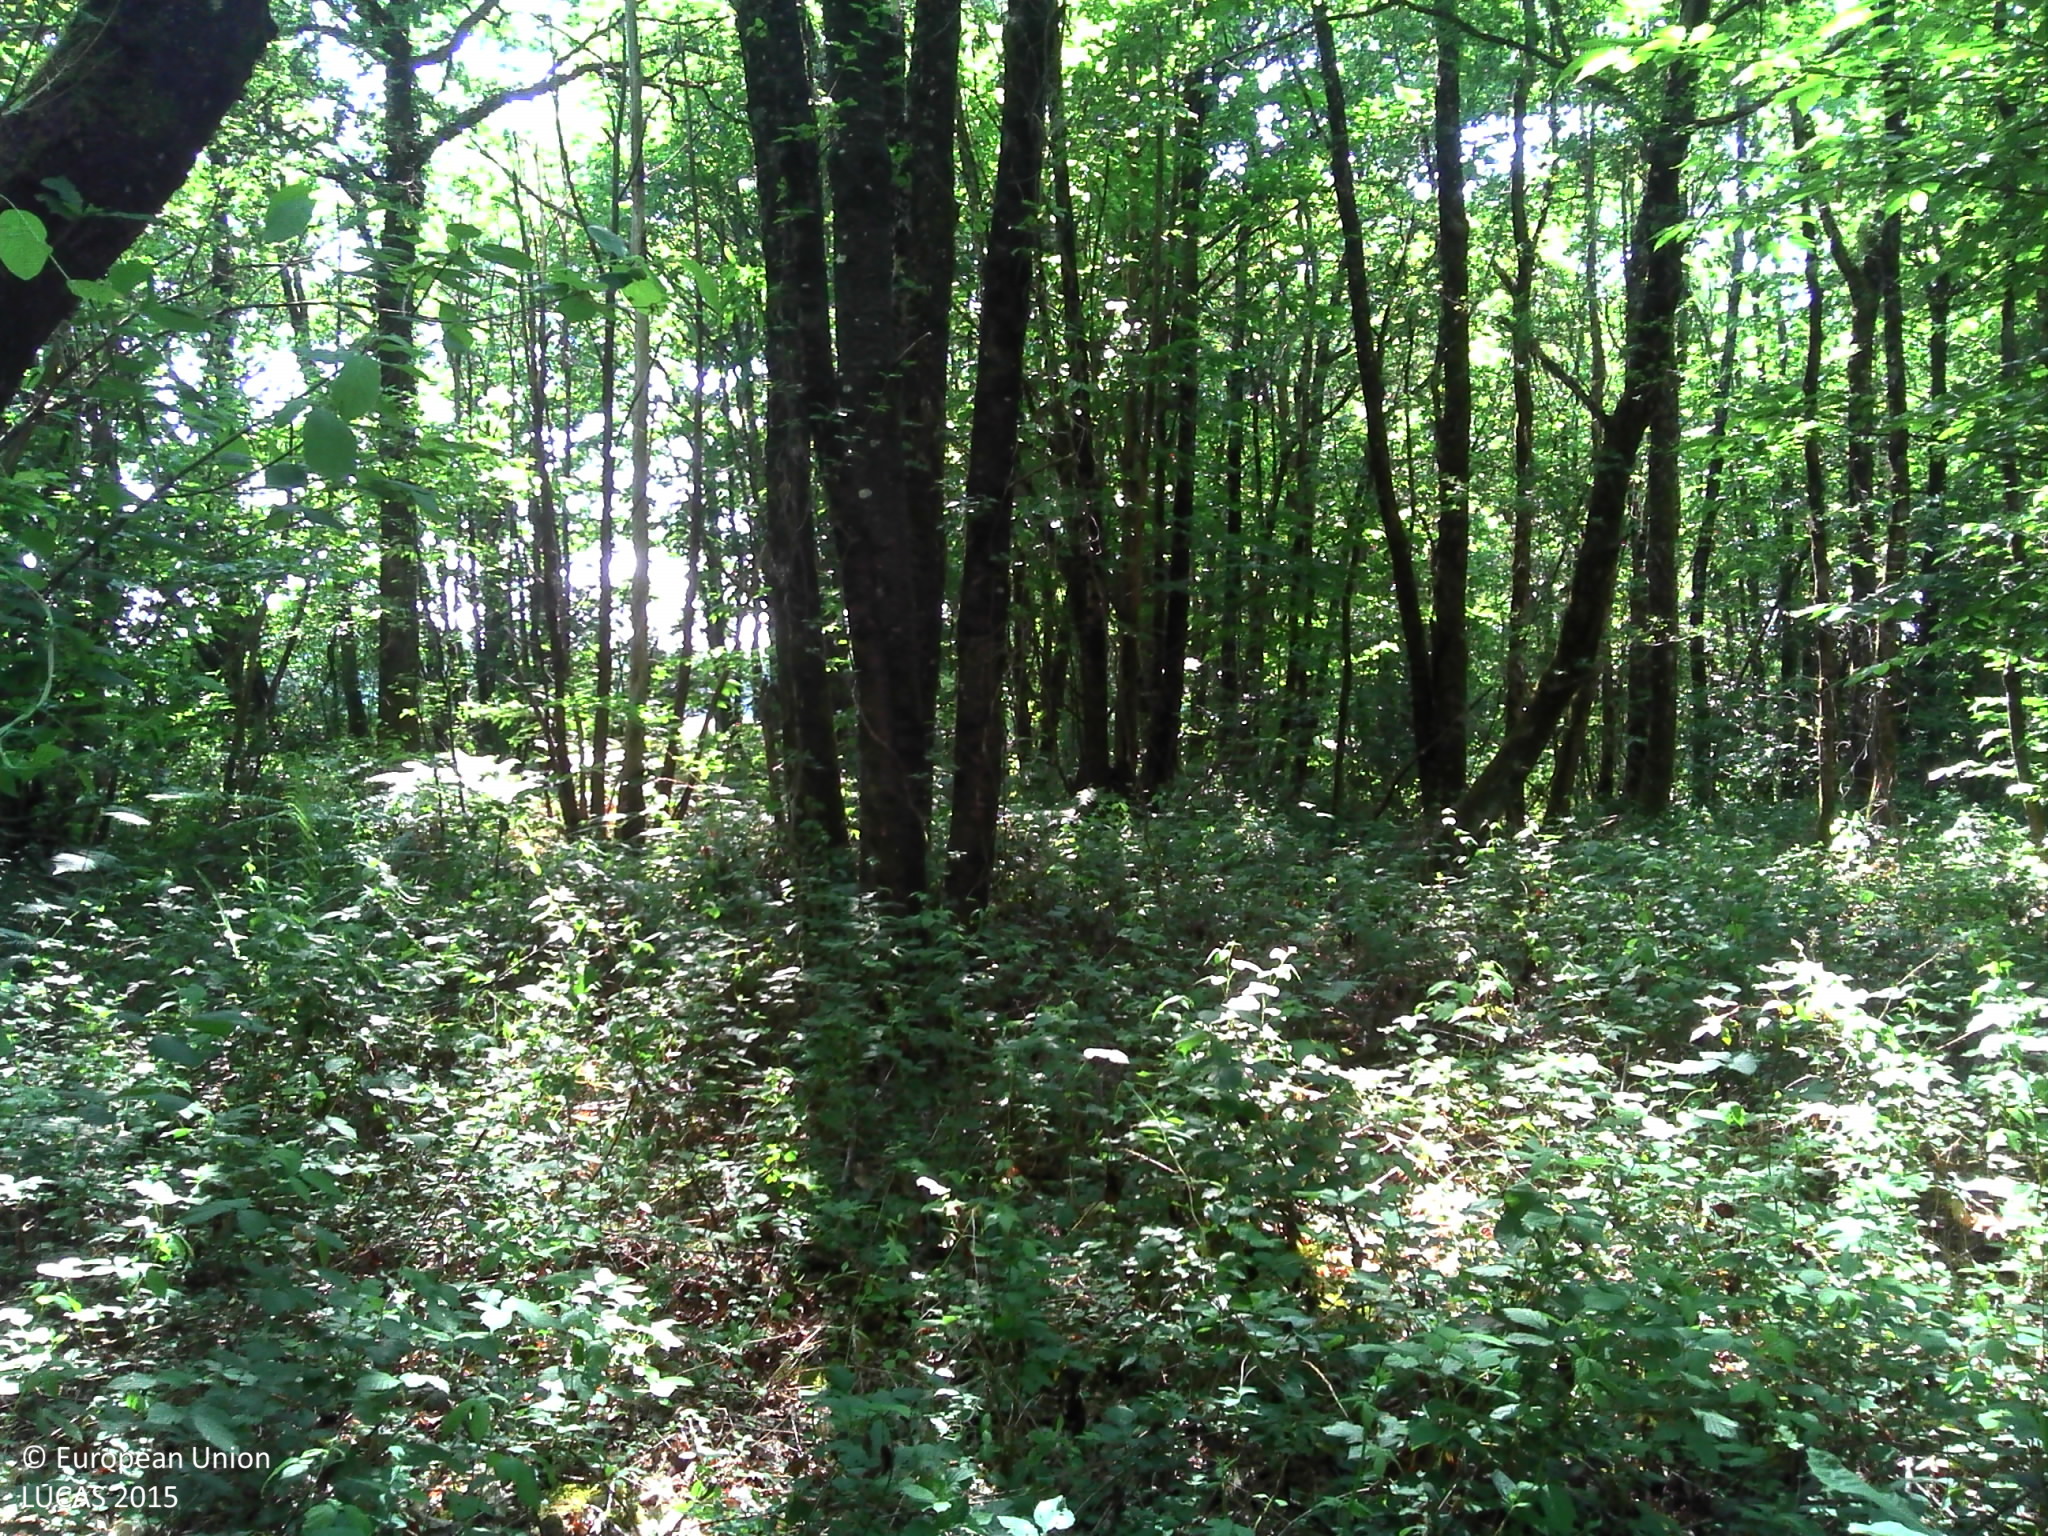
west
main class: Woodland
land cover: Broadleaved woodland
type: acidophilous oak and oak-birch forest
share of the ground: > 75 %
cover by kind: broadleaved forest trees 100 %
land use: Forestry
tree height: > 5 m
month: June
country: FR
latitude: 46.0823
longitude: 0.6098
